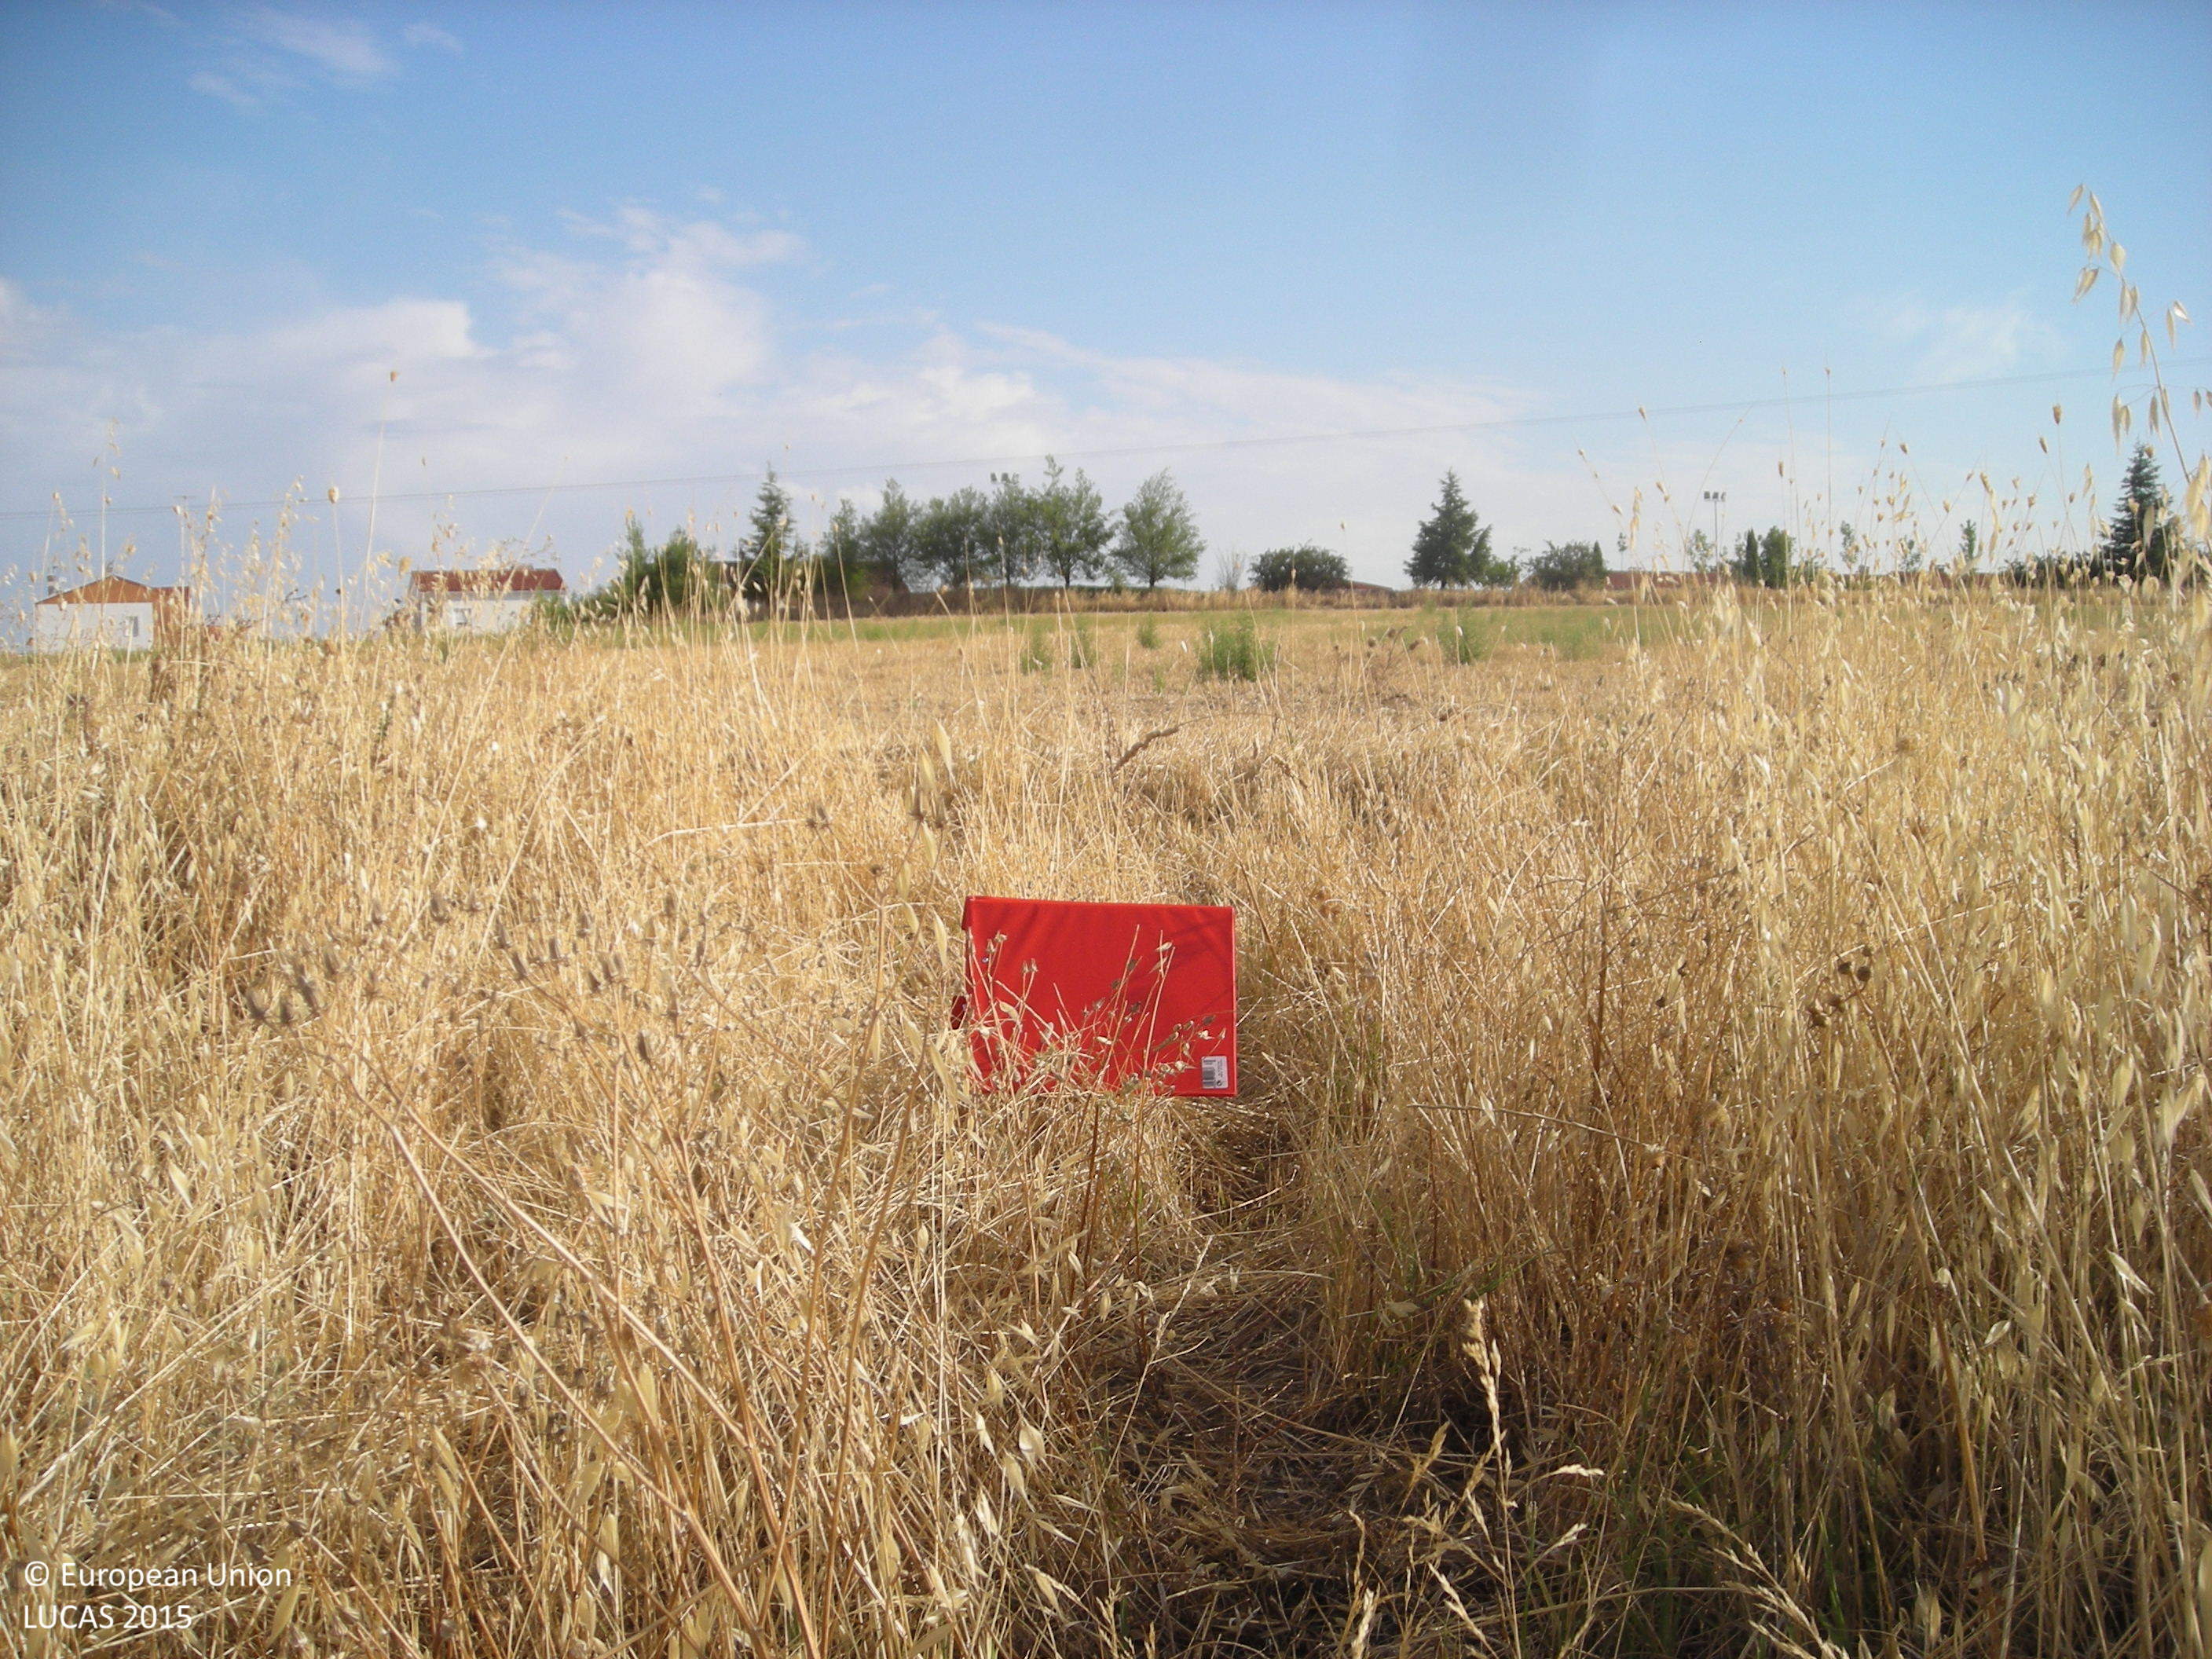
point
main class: Grassland
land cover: Spontaneously vegetated surfaces
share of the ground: 50 - 75 %
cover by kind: herbaceous plants 100 %
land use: Abandoned areas
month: July
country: ES
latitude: 39.1427
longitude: -5.9159
